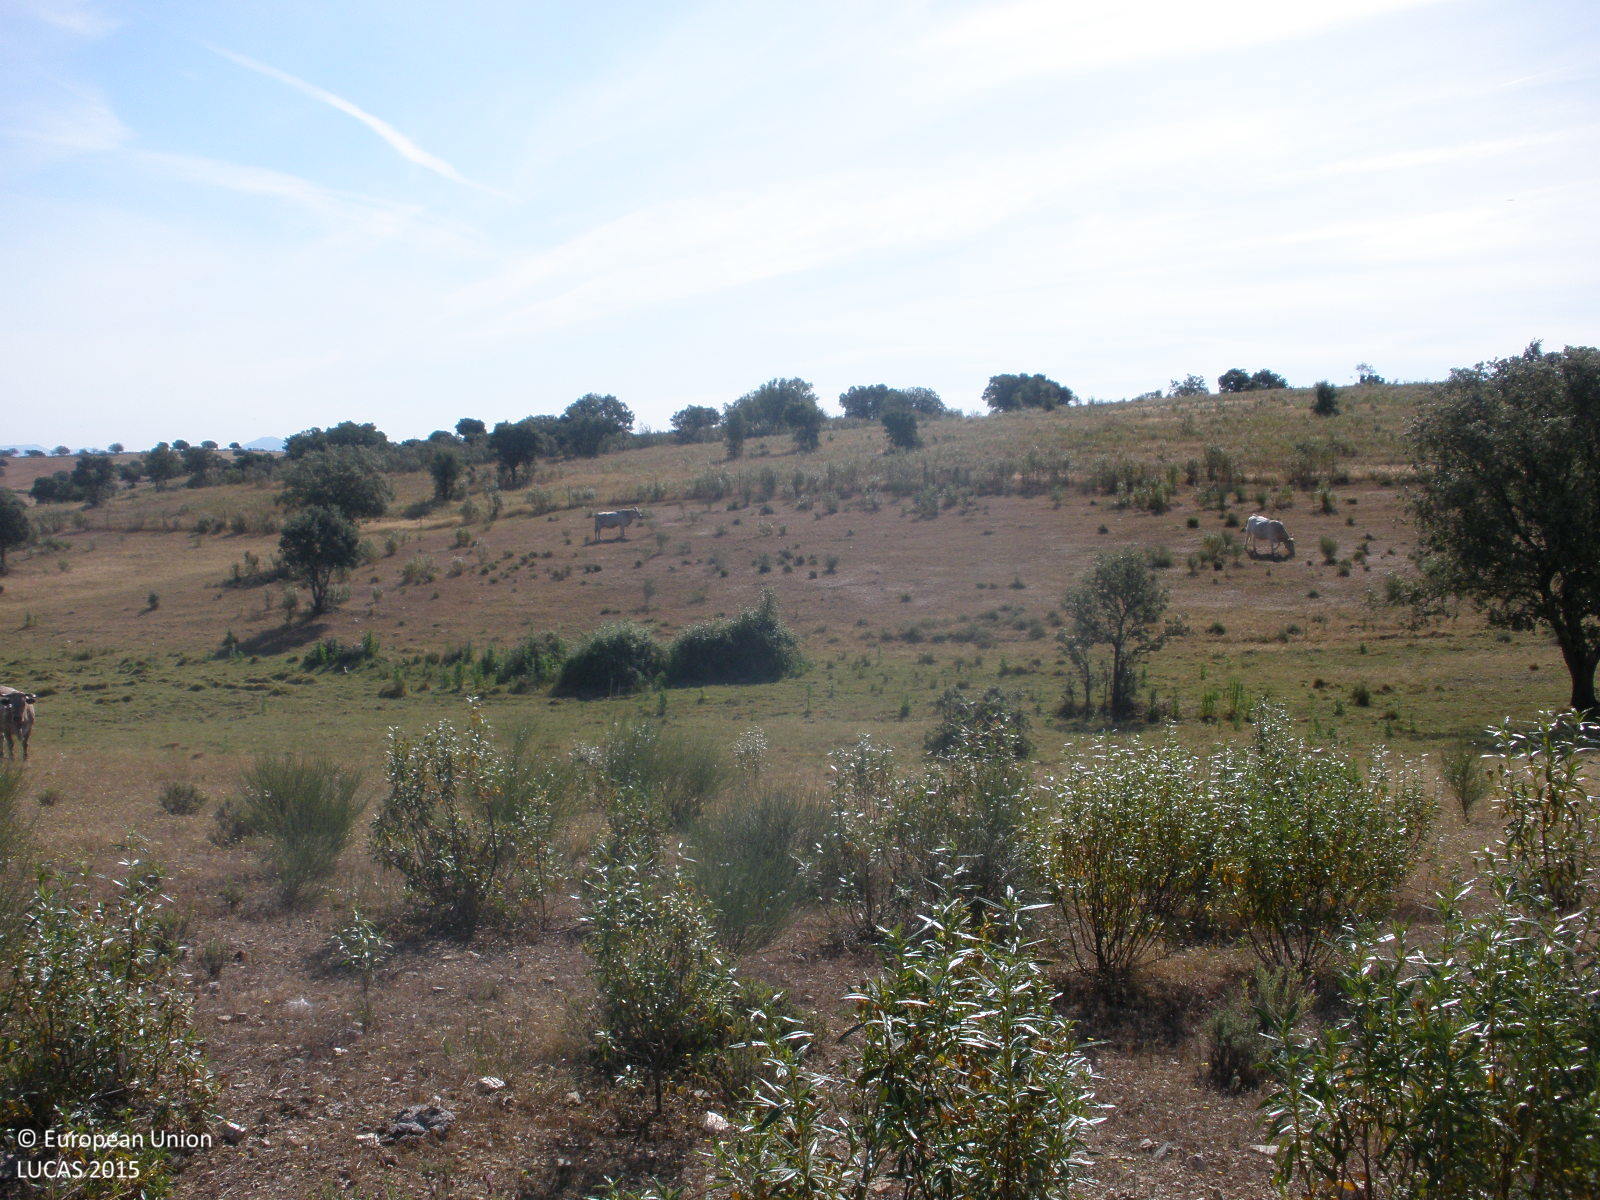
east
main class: Shrubland
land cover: Shrubland without tree cover
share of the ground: > 75 %
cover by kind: shrubs 50 %, herbaceous plants 35 %, consolidated bare surface 15 %
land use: Agriculture (excluding fallow land and kitchen gardens)
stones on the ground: 25 - 50 %
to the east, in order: Shrubland without tree cover; Grassland with sparse tree/shrub cover; Fences; Tracks; Shrubland with sparse tree cover; Tracks; Shrubland with sparse tree cover; Broadleaved woodland; Fences; Oats
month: May
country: ES
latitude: 40.0694
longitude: -6.7474
